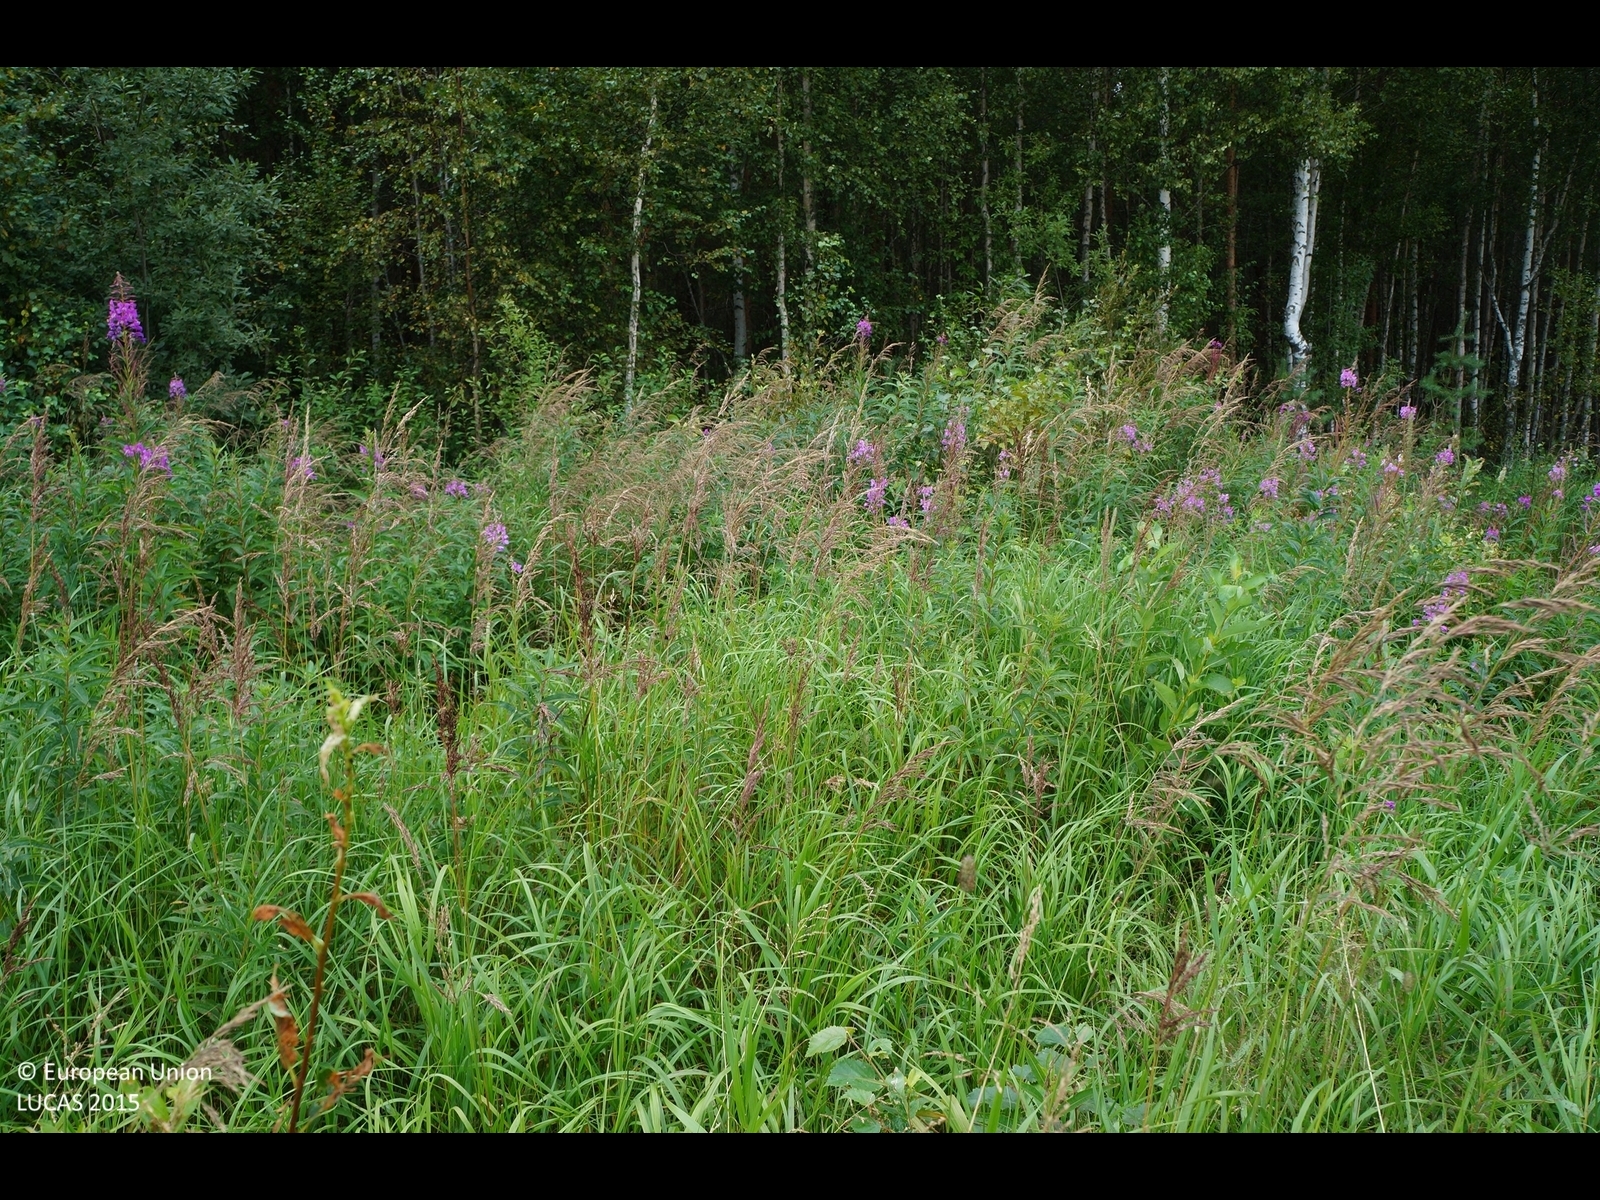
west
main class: Grassland
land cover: Grassland without tree/shrub cover
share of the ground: > 75 %
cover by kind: herbaceous plants 95 %, shrubs 5 %
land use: Electricity, gas and thermal power distribution
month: August
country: FI
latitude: 64.7528
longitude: 24.9736
